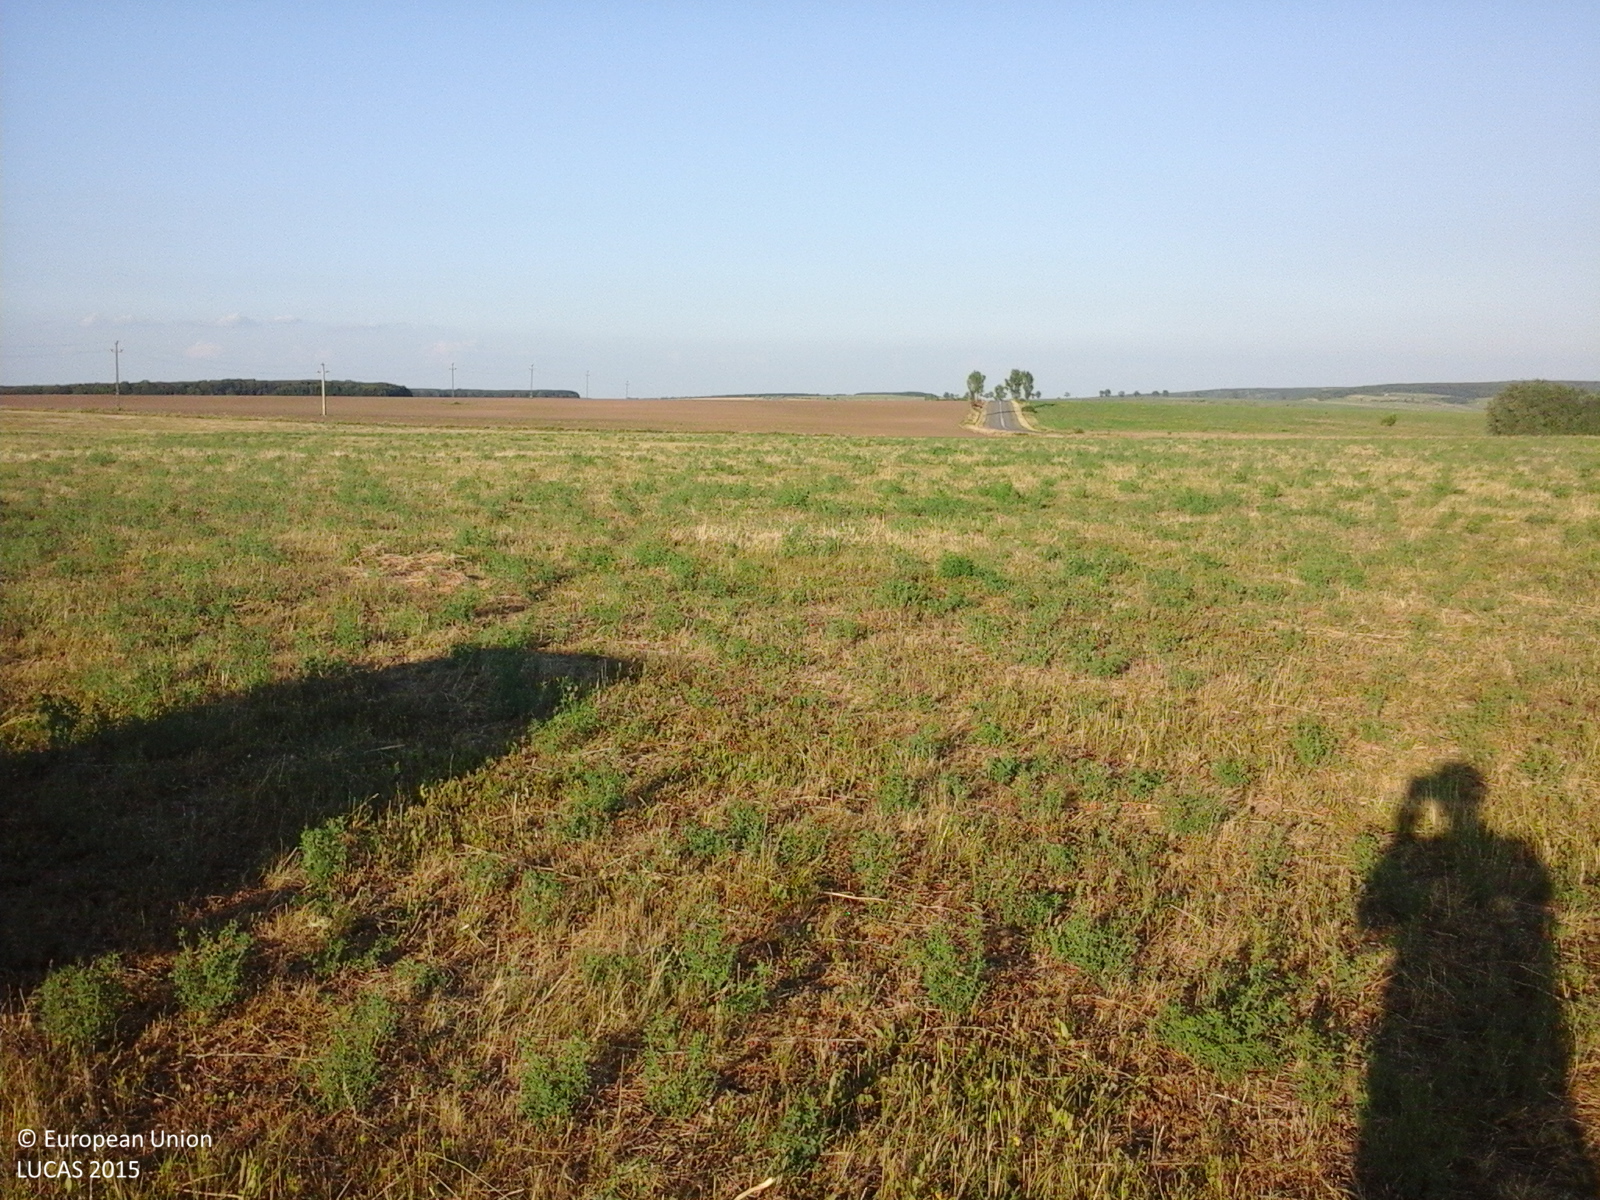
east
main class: Cropland
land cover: Lucerne
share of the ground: 25 - 50 %
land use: Agriculture (excluding fallow land and kitchen gardens)
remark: Harvested field
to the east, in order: Lucerne; Grass margins; Tracks; Other bare soil
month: June
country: RO
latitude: 47.7523
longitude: 26.8957
